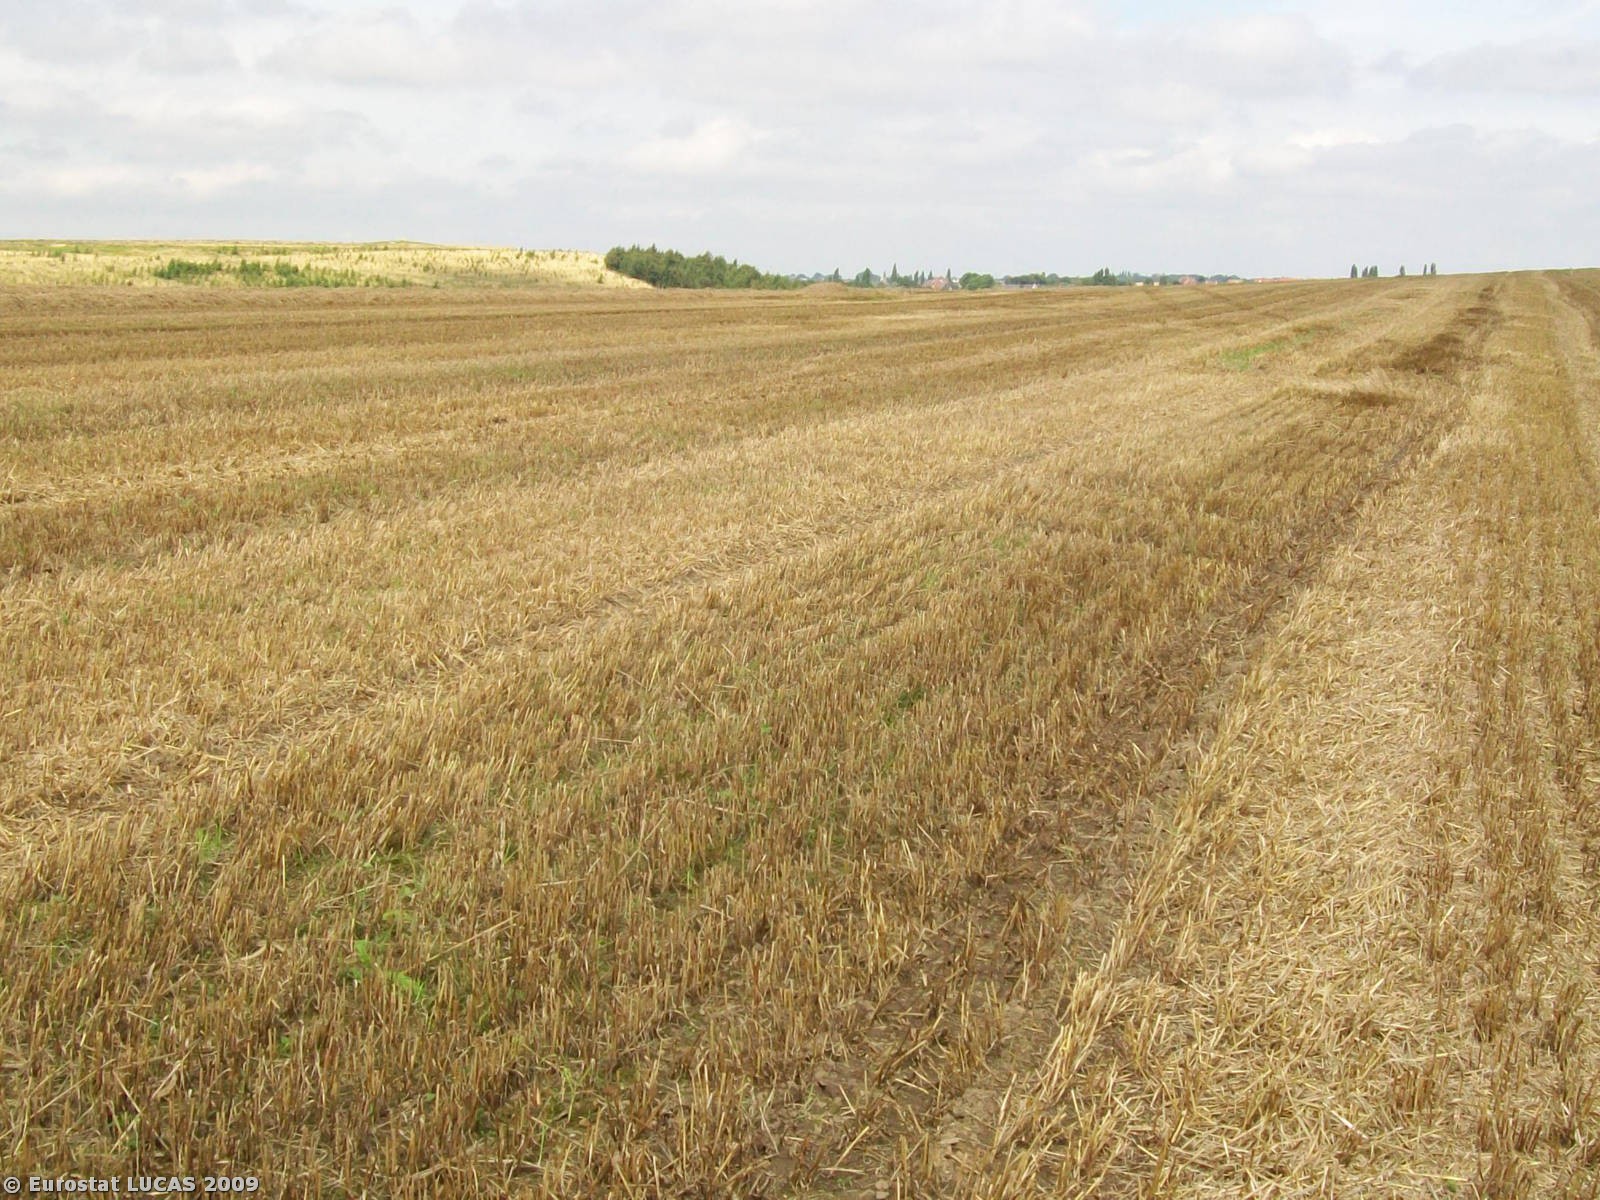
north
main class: Cropland
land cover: Common wheat
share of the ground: < 10 %
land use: Agriculture (excluding fallow land and kitchen gardens)
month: August
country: GB
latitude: 53.3286
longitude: -1.2632
